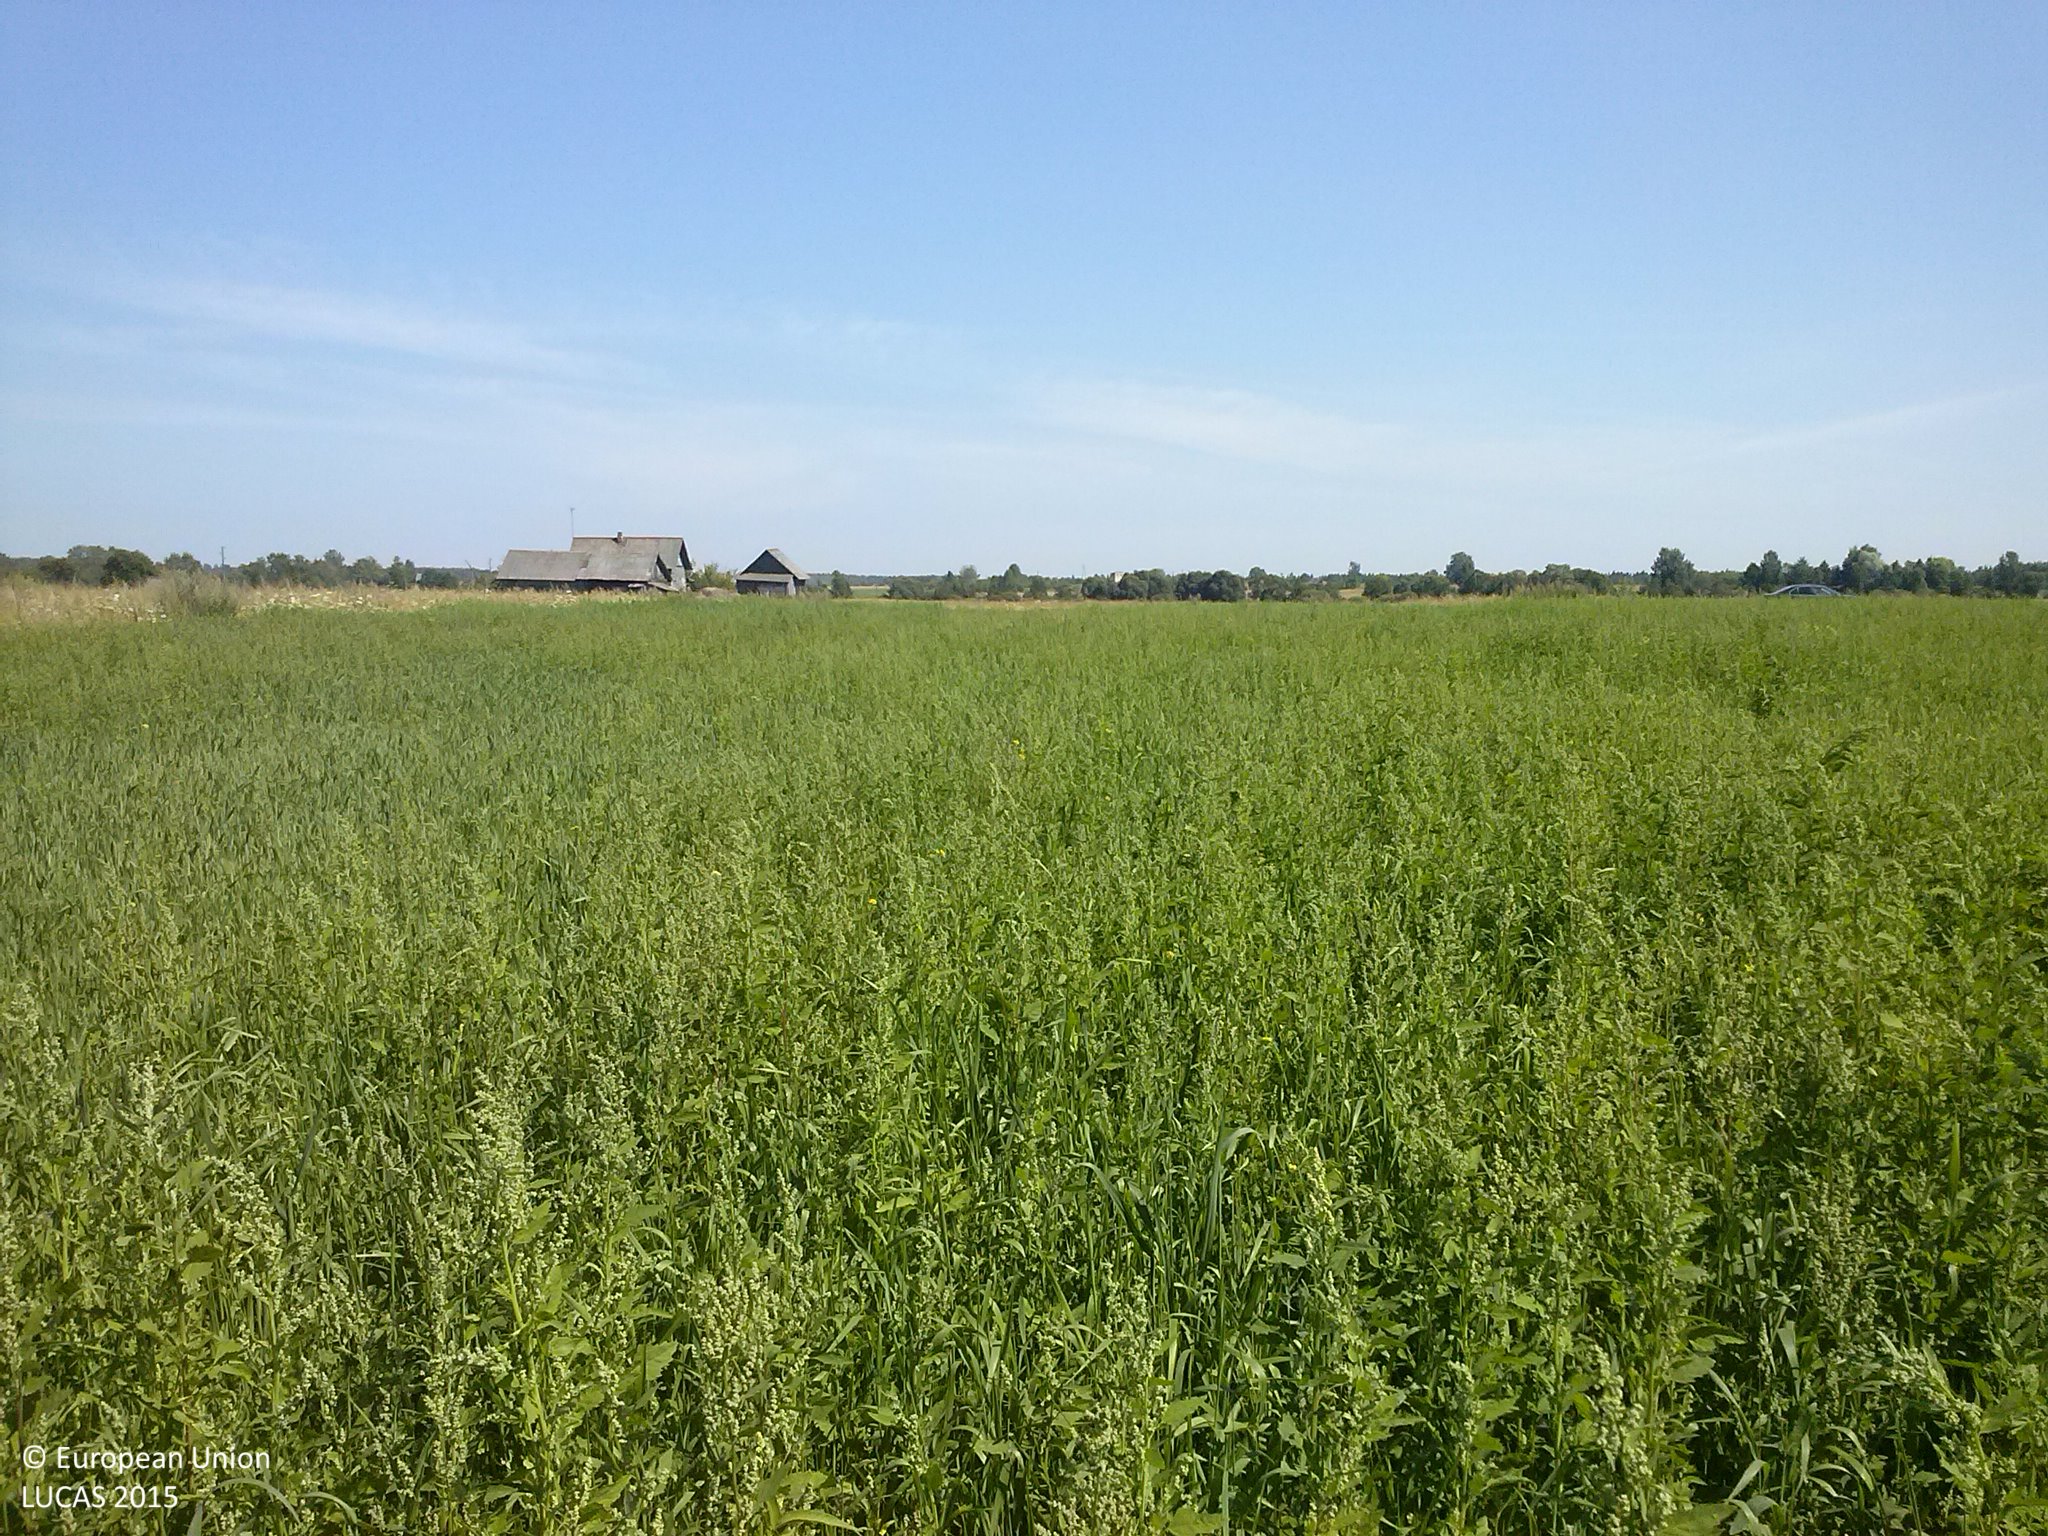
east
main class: Grassland
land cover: Grassland without tree/shrub cover
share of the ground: > 75 %
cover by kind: herbaceous plants 100 %
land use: Agriculture (excluding fallow land and kitchen gardens)
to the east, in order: Grassland without tree/shrub cover; Tracks; Grassland without tree/shrub cover; Durum wheat
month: August
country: LV
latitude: 56.7344
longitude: 27.8270
